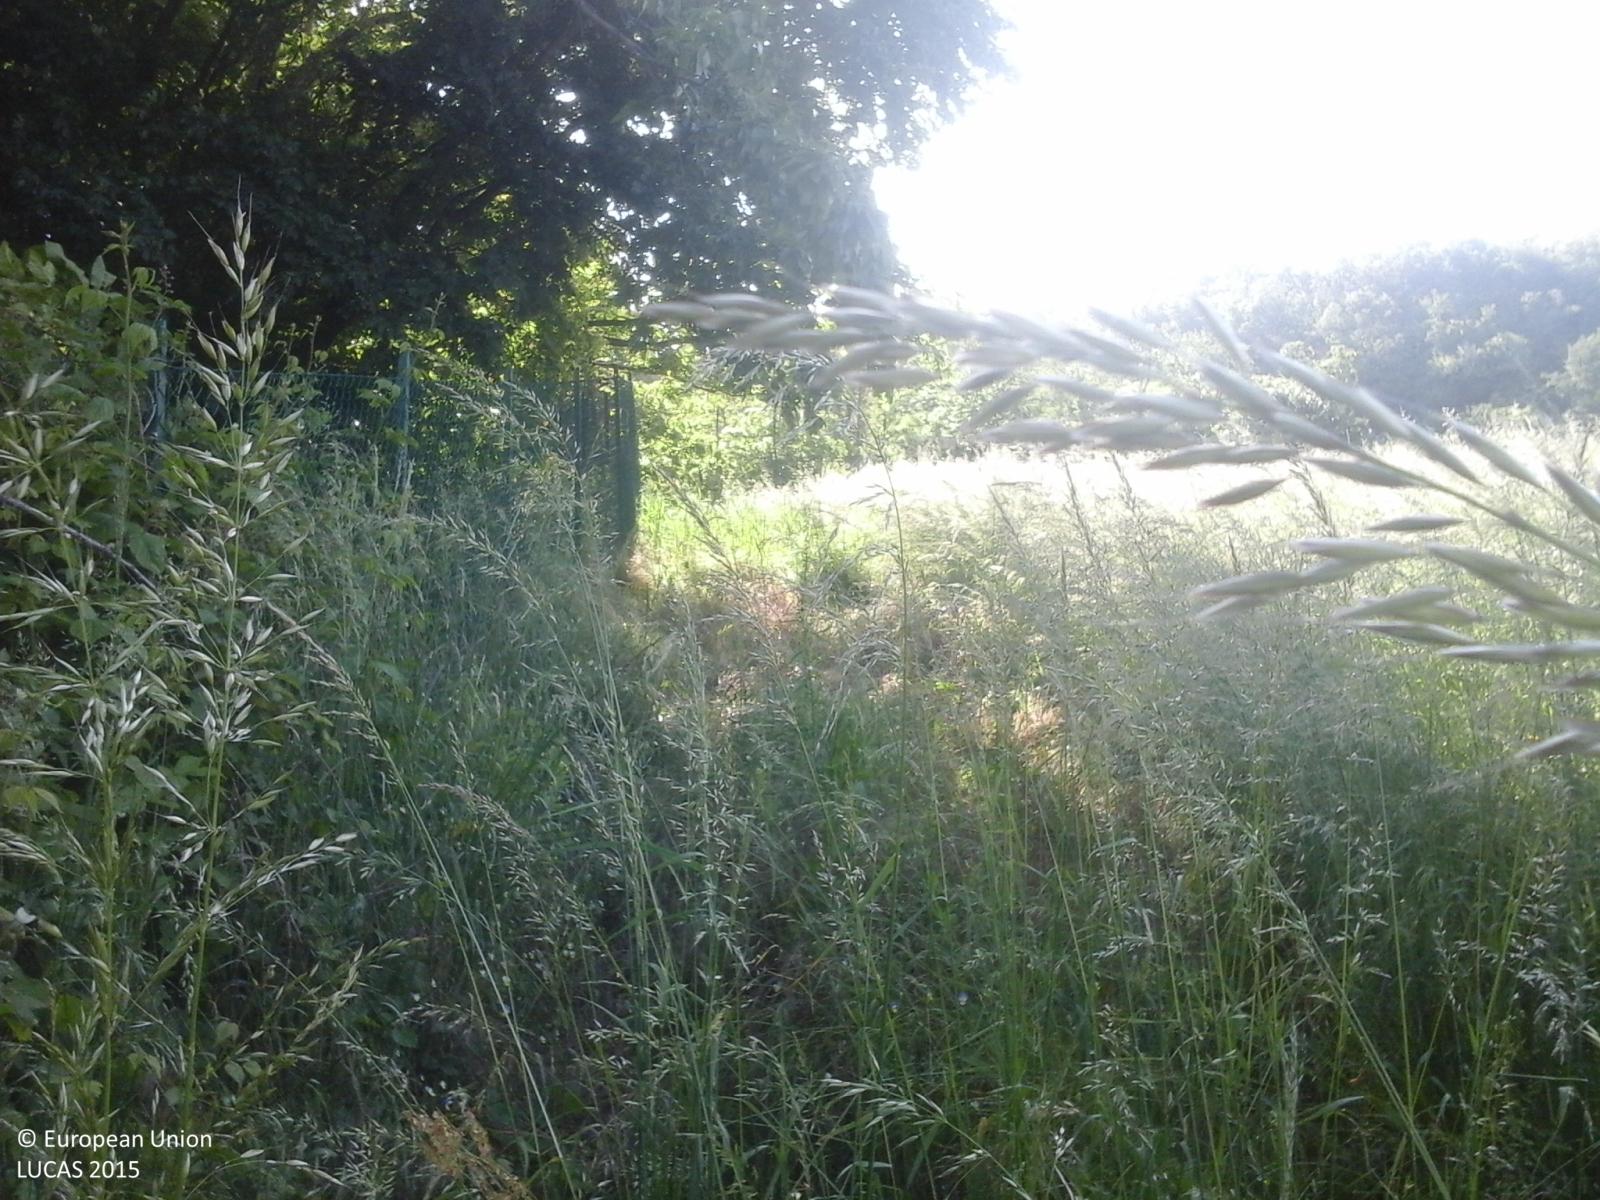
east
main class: Woodland
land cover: Broadleaved woodland
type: thermophilous deciduous forest
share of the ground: > 75 %
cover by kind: broadleaved forest trees 90 %, shrubs 10 %
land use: Forestry
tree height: > 5 m
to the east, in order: Broadleaved woodland; Fences; Broadleaved woodland; Paved roads, cycling and walking lanes; Broadleaved woodland
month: May
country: IT
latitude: 44.3451
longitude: 11.0638
